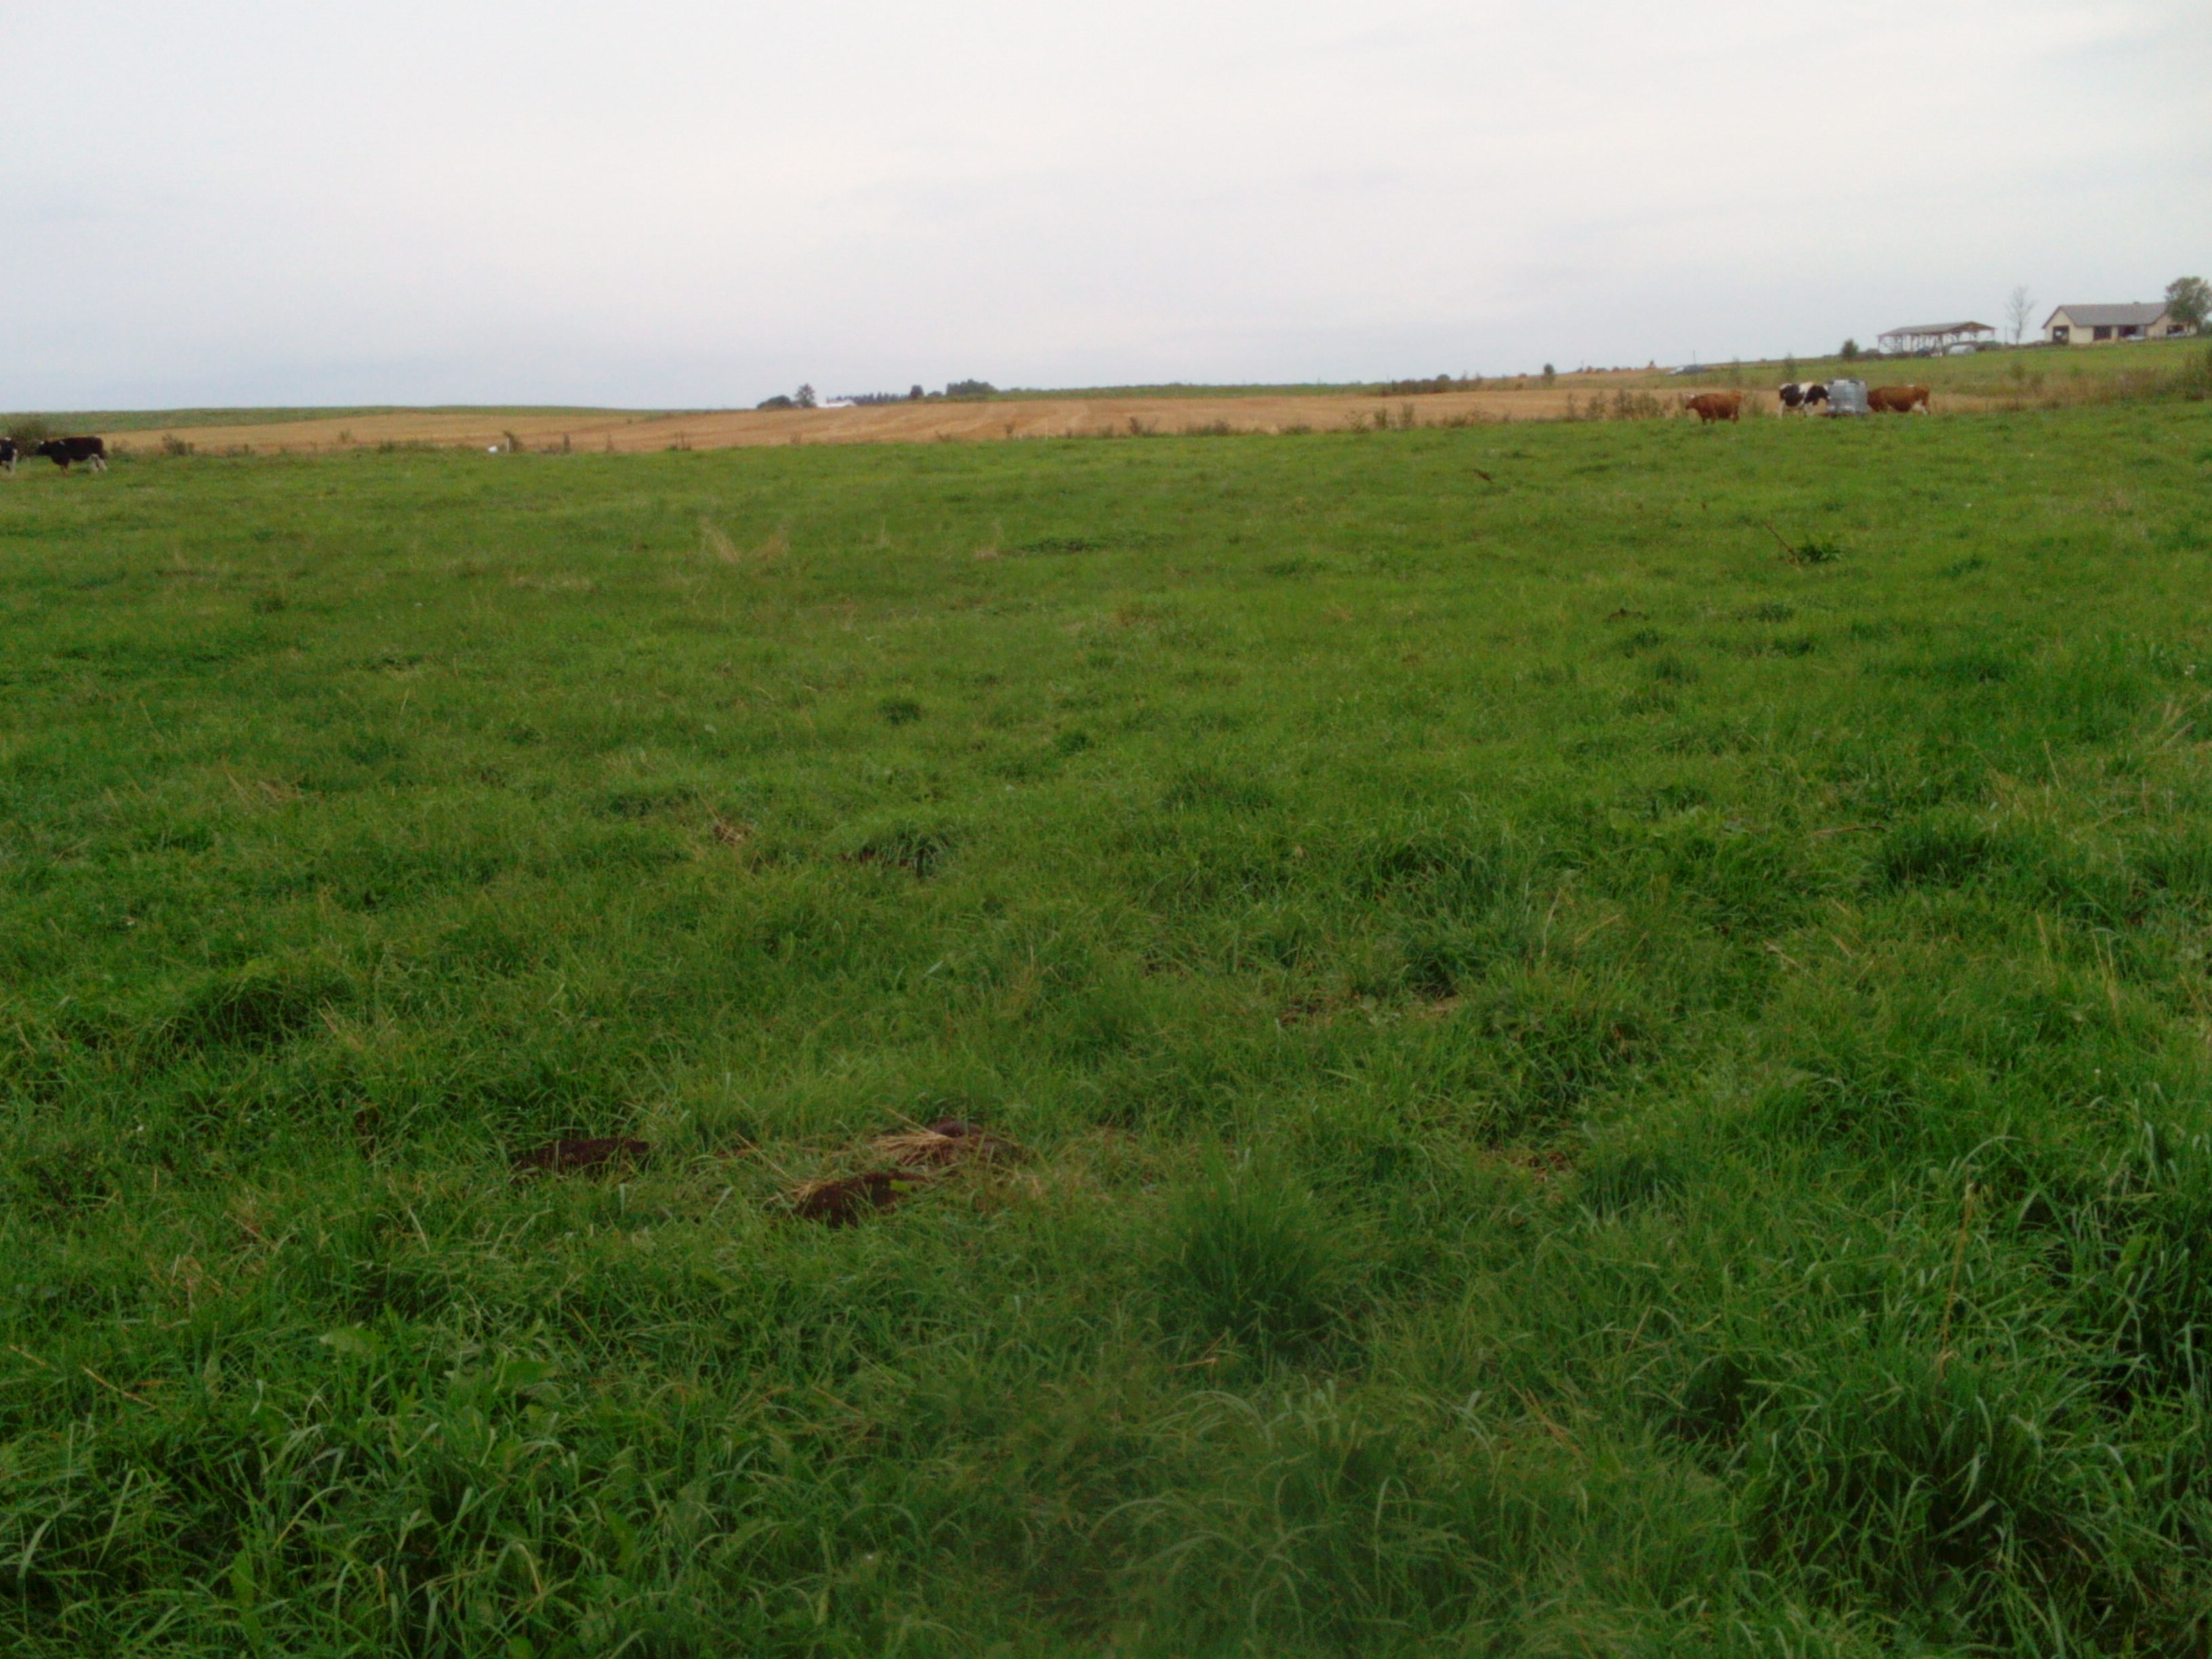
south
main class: Grassland
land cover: Grassland without tree/shrub cover
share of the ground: > 75 %
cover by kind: herbaceous plants 100 %
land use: Agriculture (excluding fallow land and kitchen gardens)
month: September
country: LT
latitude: 55.7767
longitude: 22.8360
